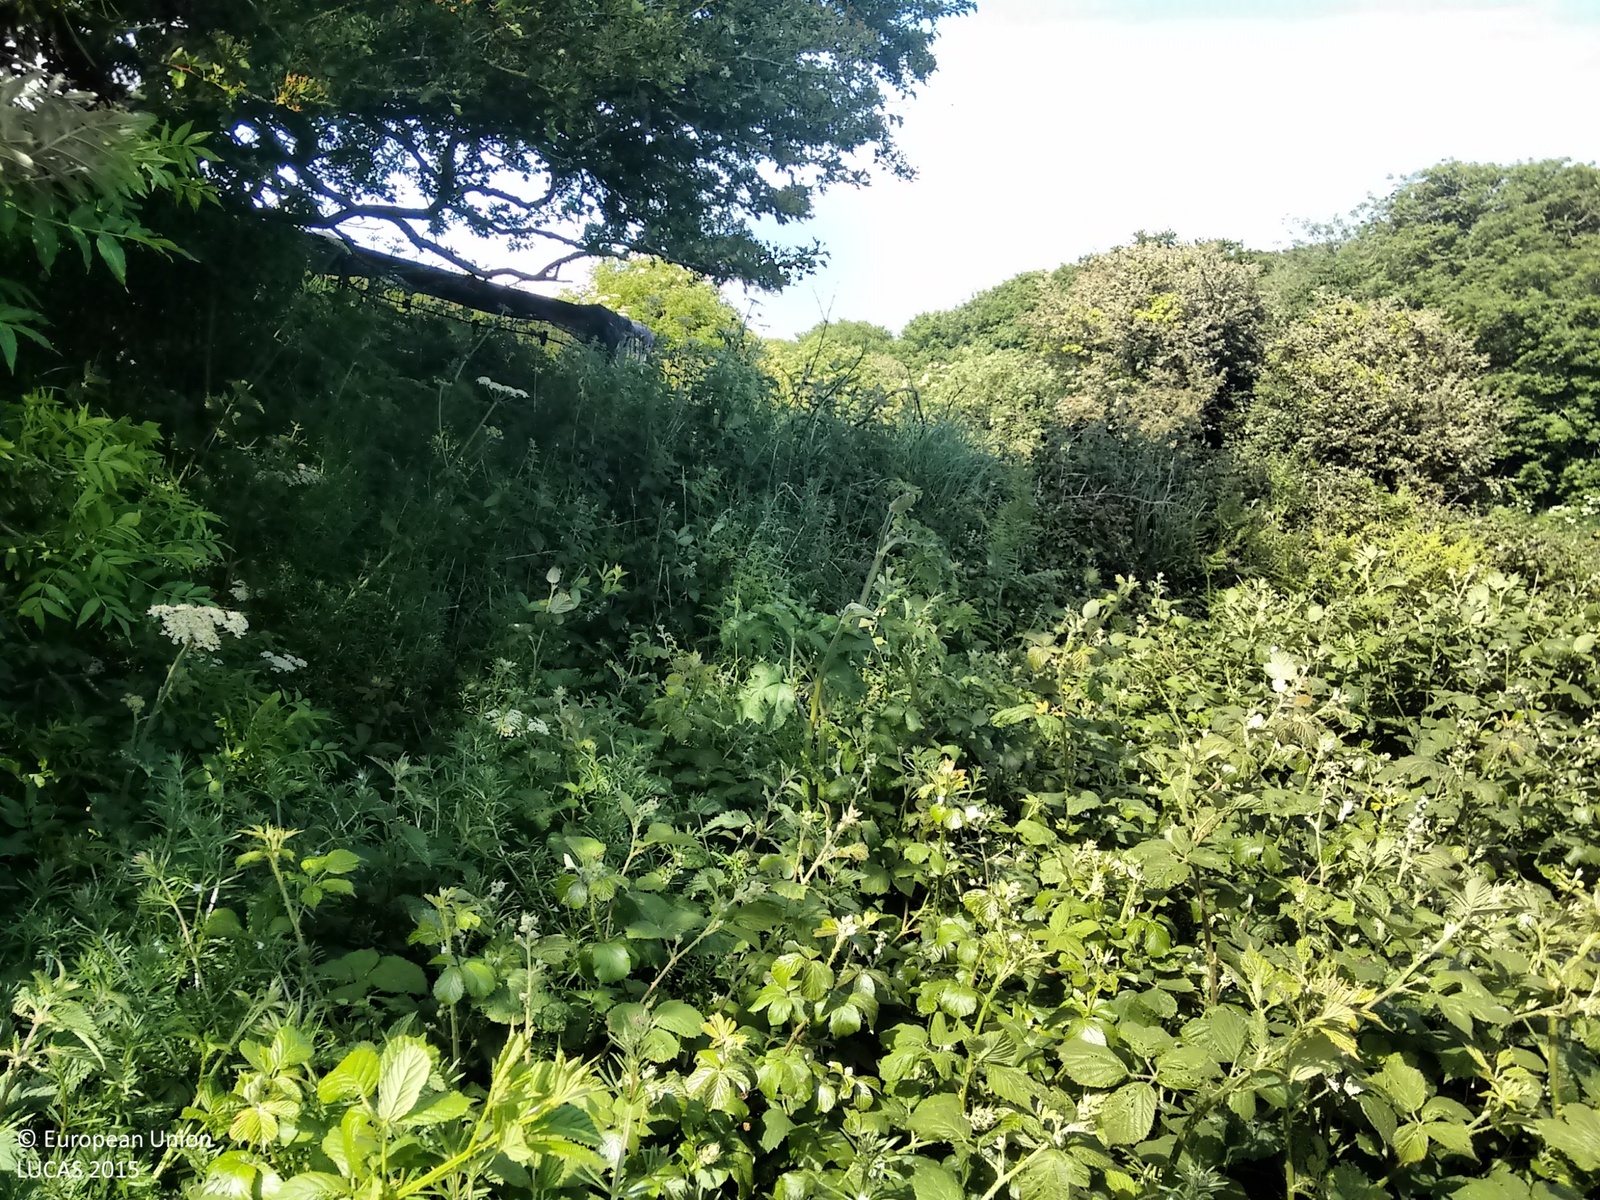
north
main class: Shrubland
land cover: Shrubland with sparse tree cover
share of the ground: > 75 %
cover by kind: shrubs 95 %, broadleaved forest trees 5 %
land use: Semi-natural and natural areas not in use
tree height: > 5 m
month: June
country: IE
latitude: 51.8749
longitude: -7.9685
